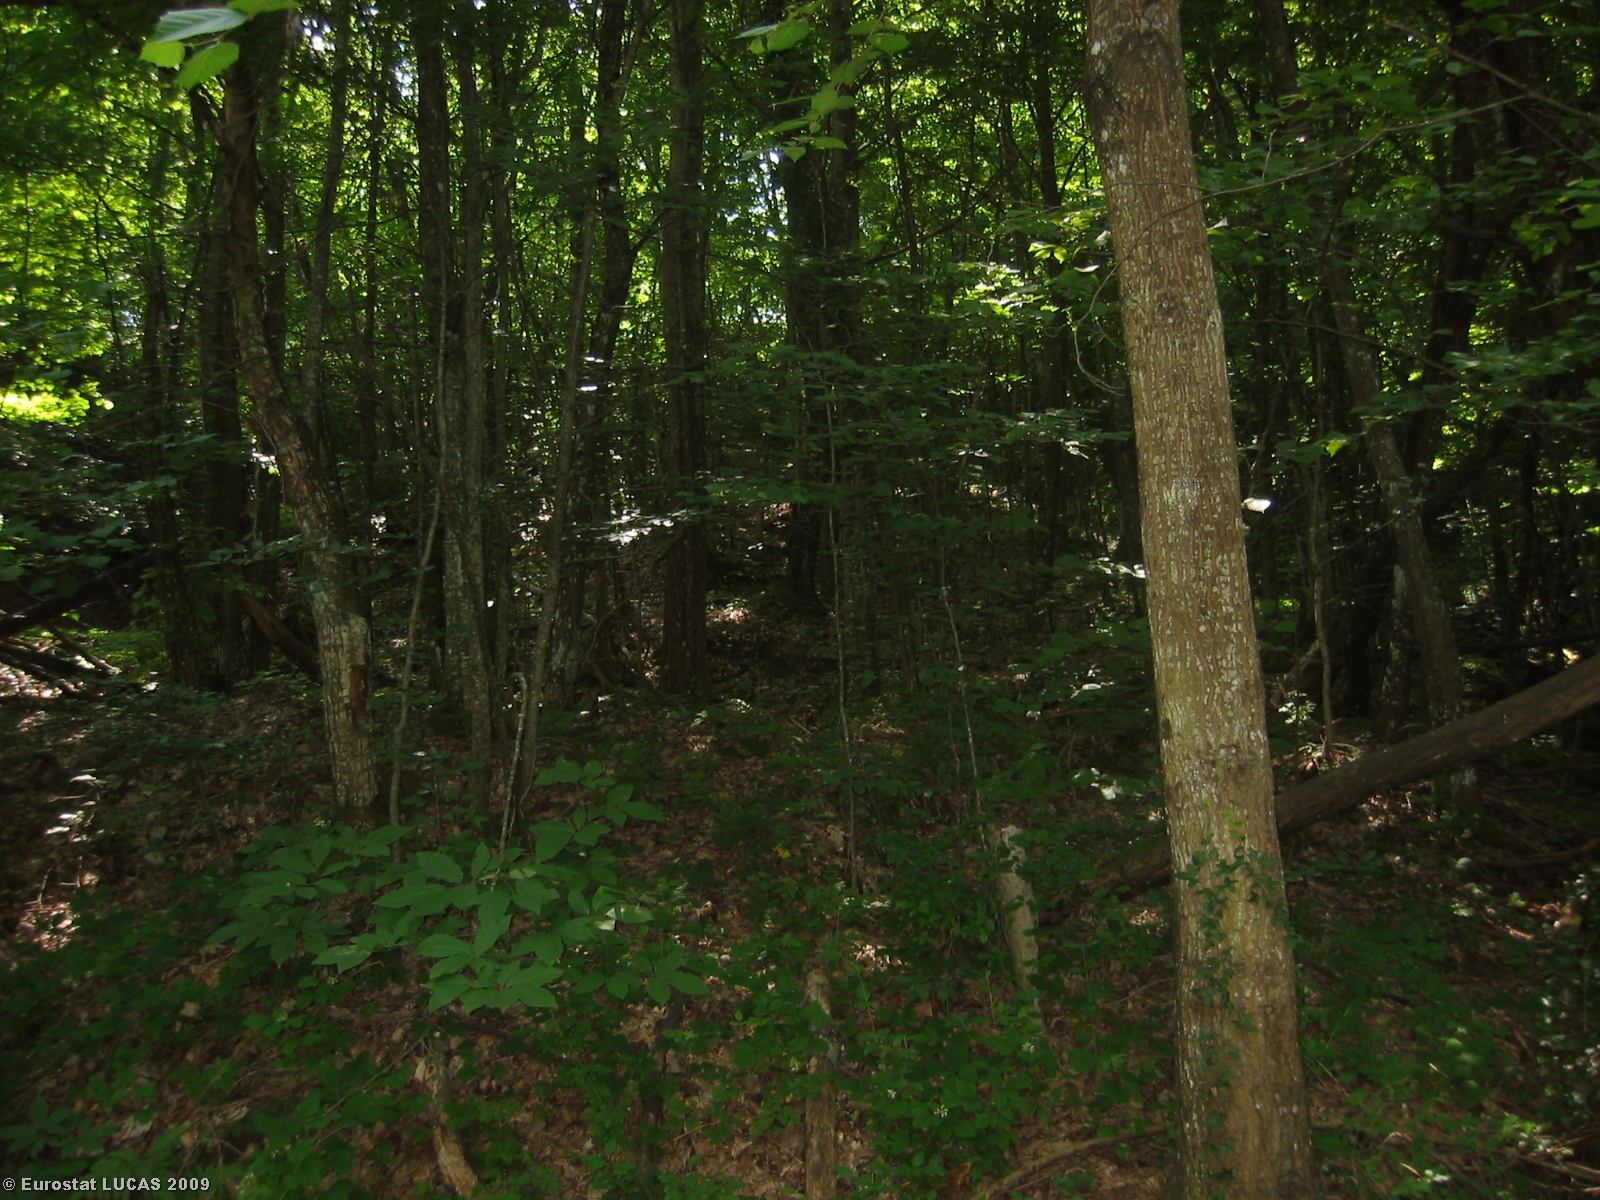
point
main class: Woodland
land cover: Mixed woodland
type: mesophytic deciduous forest
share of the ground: > 75 %
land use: Unused
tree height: > 5 m
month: July
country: IT
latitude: 44.2572
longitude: 10.8122
